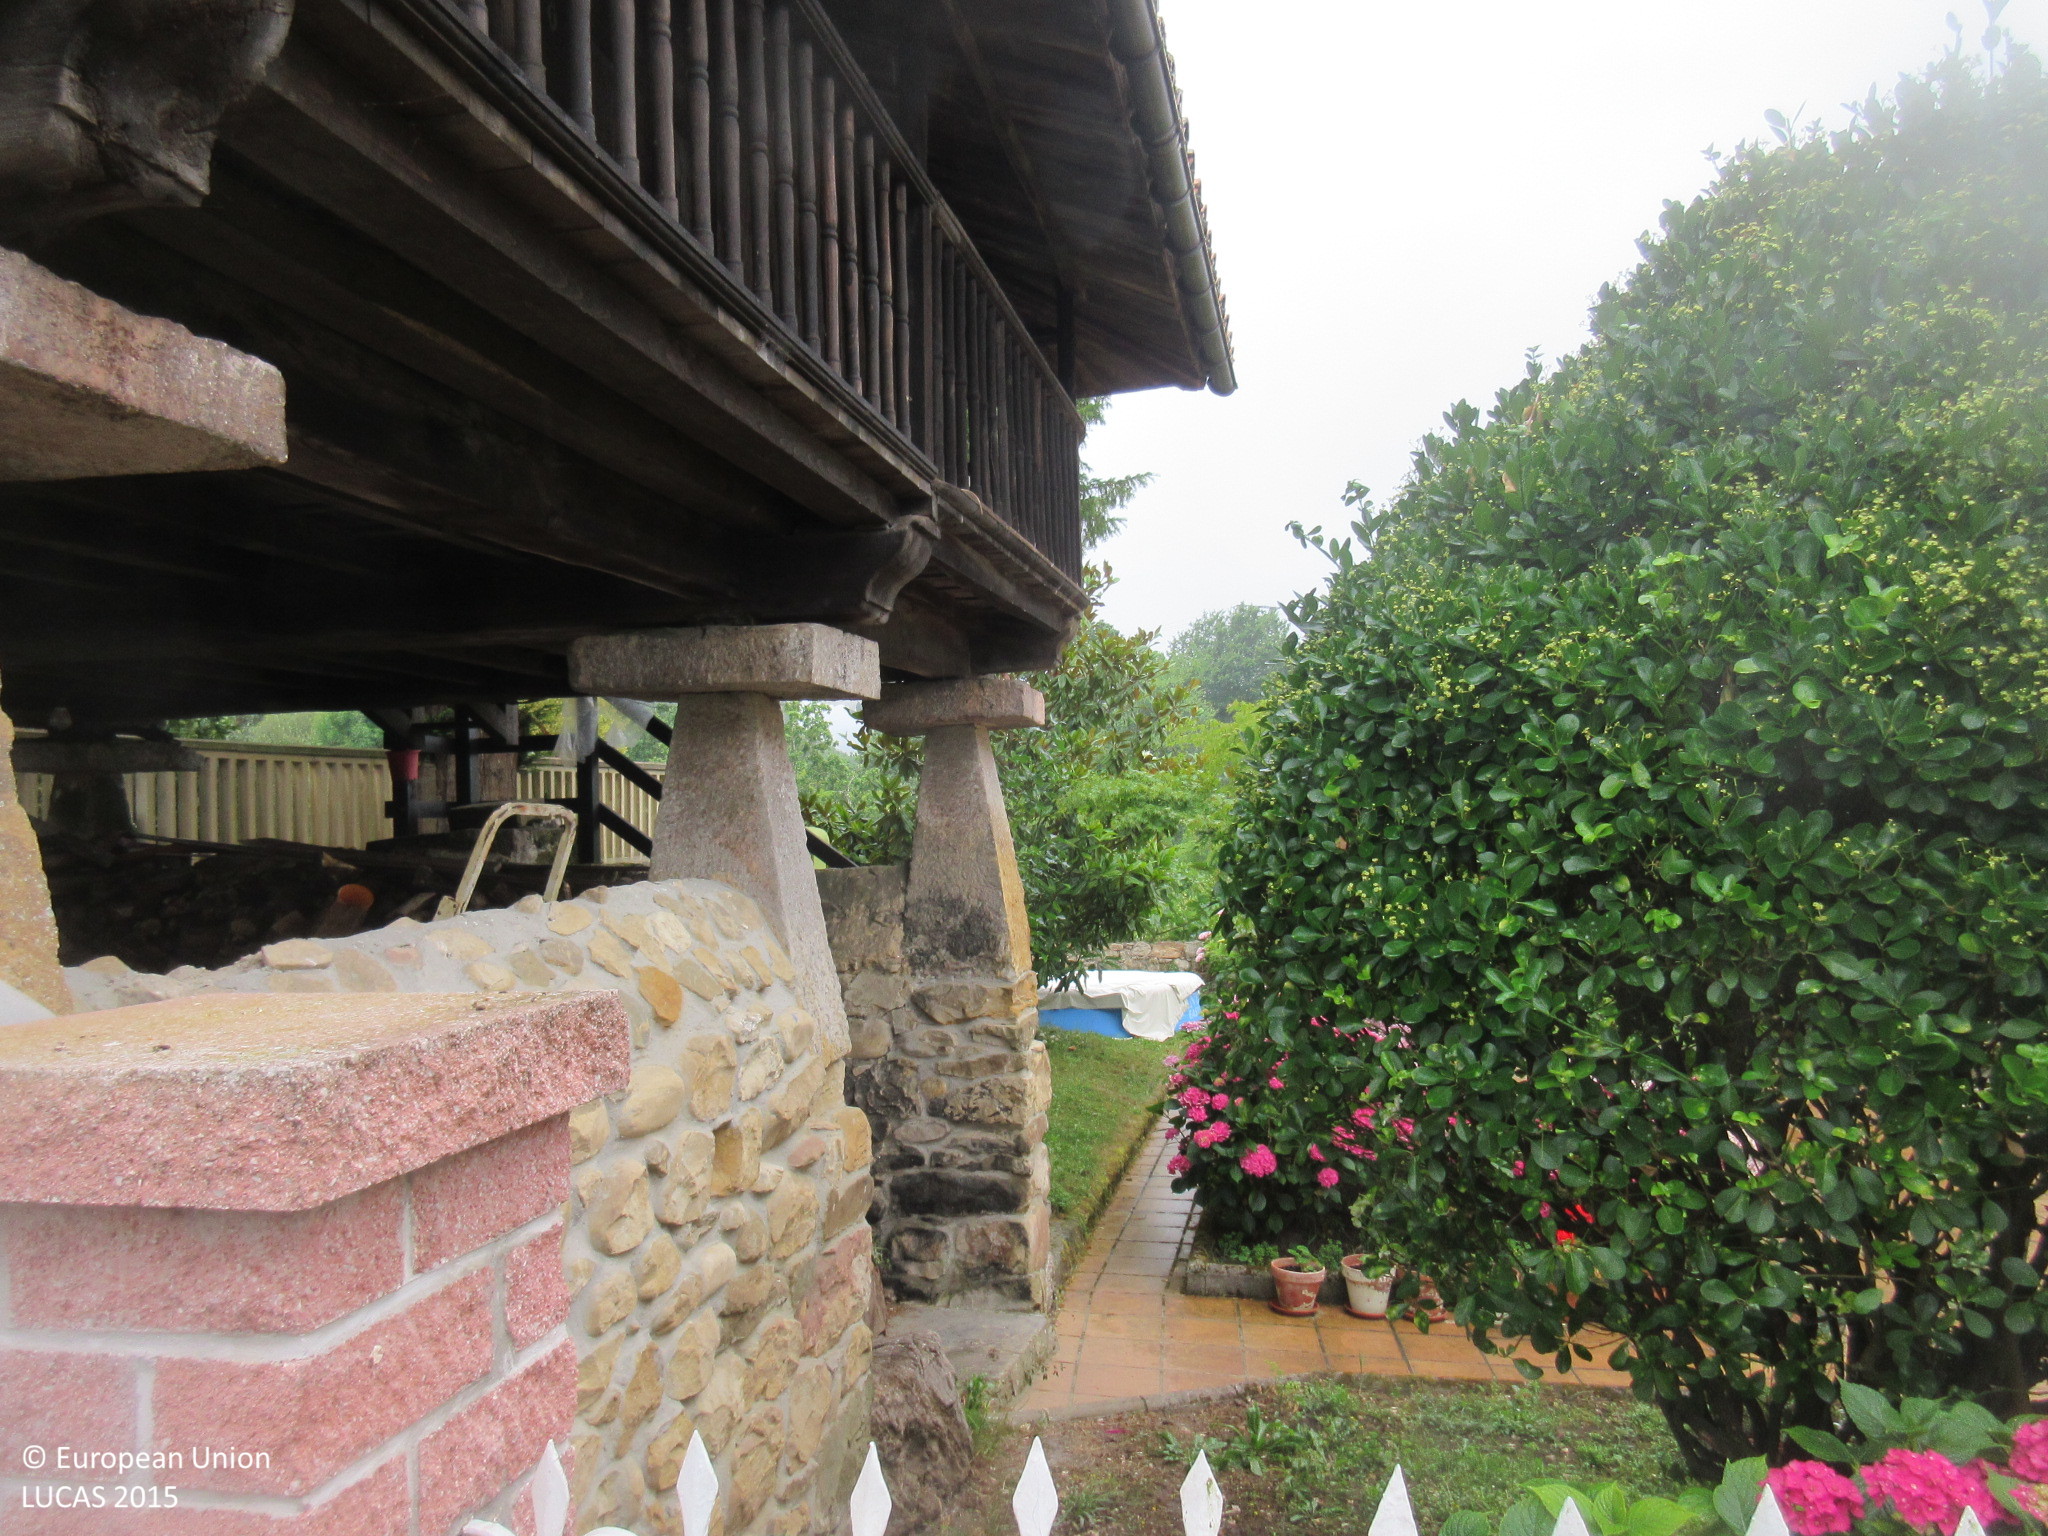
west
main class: Grassland
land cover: Grassland with sparse tree/shrub cover
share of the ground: > 75 %
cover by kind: herbaceous plants 95 %, broadleaved forest trees 5 %
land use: Residential
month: July
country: ES
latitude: 43.3600
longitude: -5.2644
